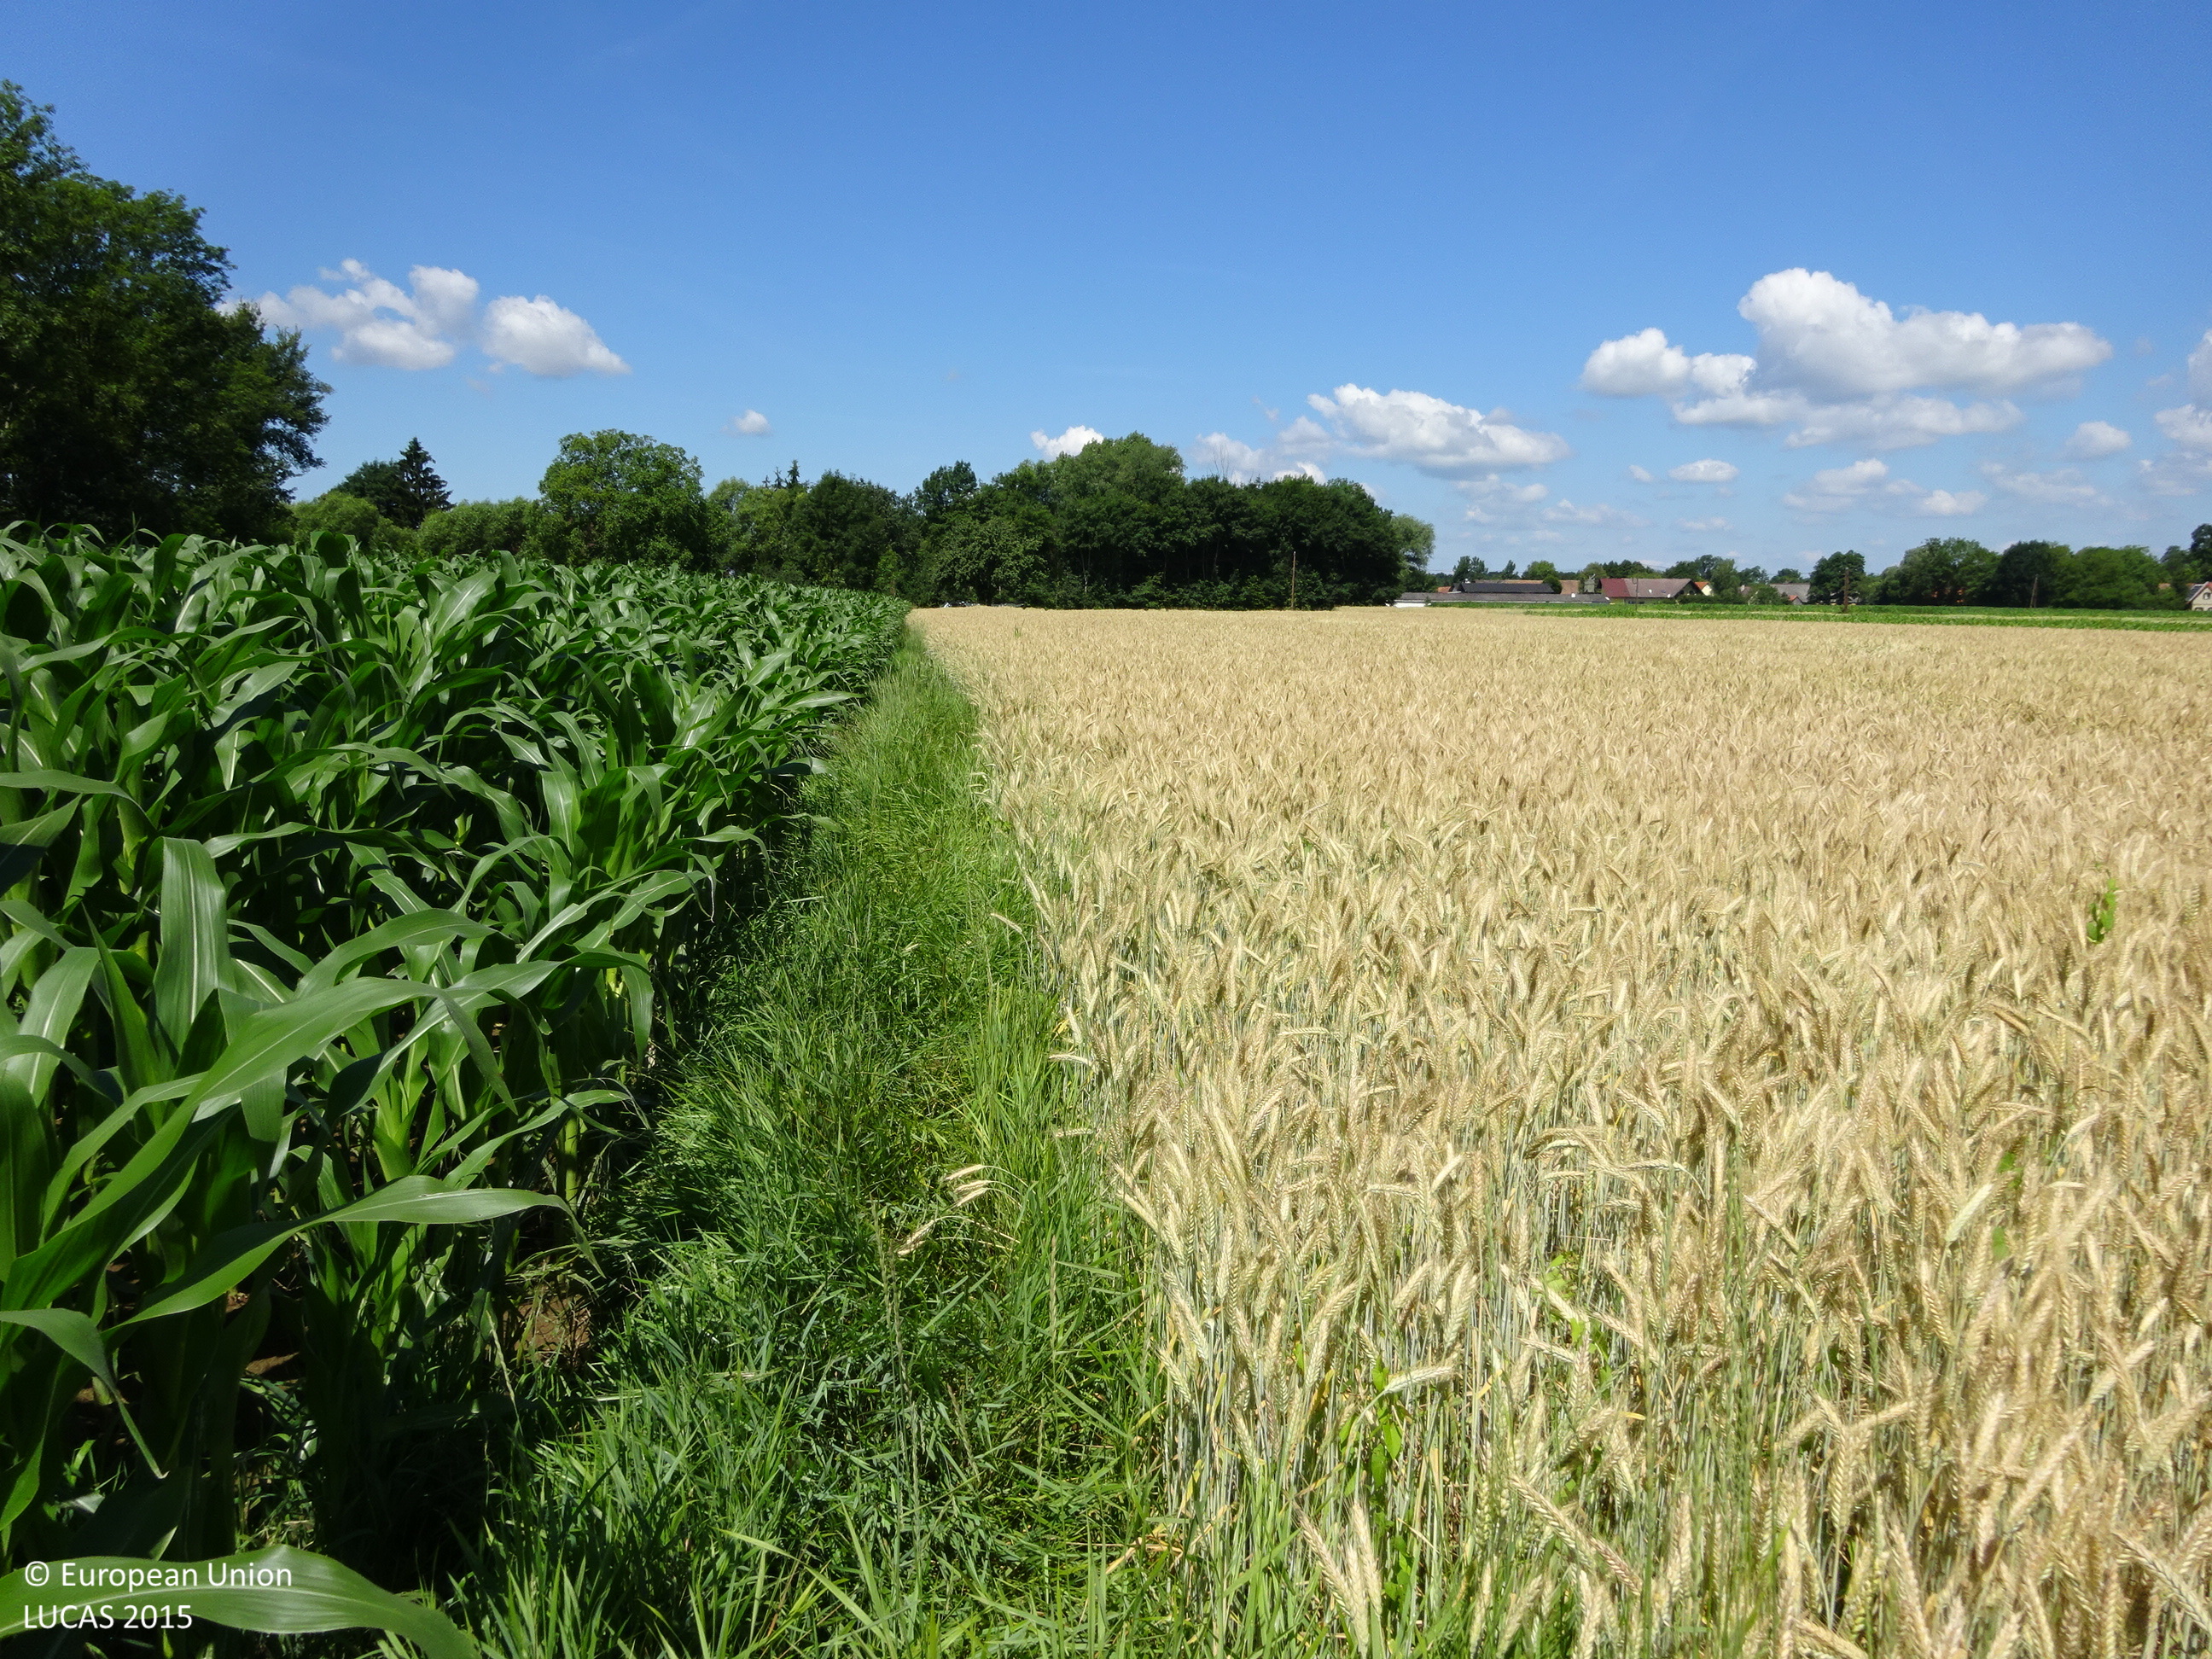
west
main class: Cropland
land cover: Common wheat
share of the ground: > 75 %
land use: Agriculture (excluding fallow land and kitchen gardens)
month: June
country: AT
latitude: 46.7091
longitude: 15.9518
